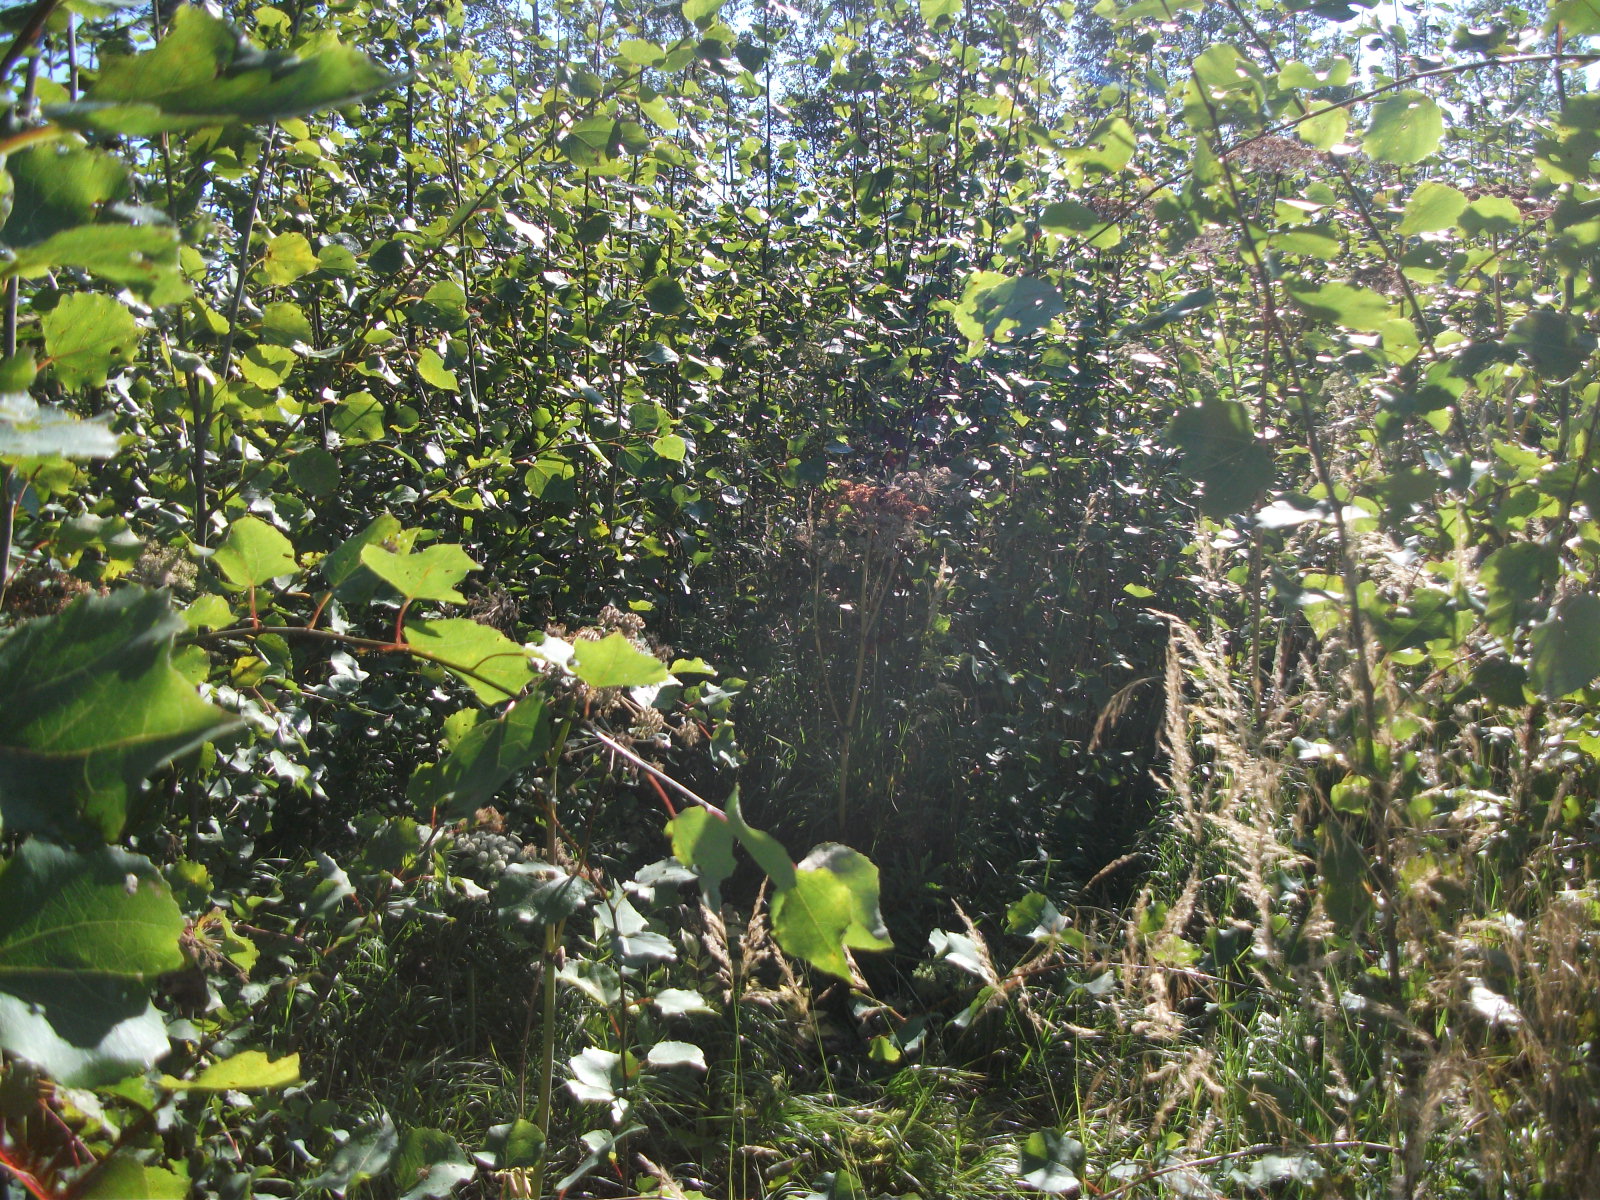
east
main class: Woodland
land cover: Broadleaved woodland
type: non-riverine alder, birch or aspen forest
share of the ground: > 75 %
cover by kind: broadleaved forest trees 80 %, shrubs 10 %, herbaceous plants 10 %
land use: Forestry
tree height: < 5 m
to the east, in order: Broadleaved woodland; Ditches and canals; Grassland without tree/shrub cover
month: August
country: LV
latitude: 56.2874
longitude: 26.3479
